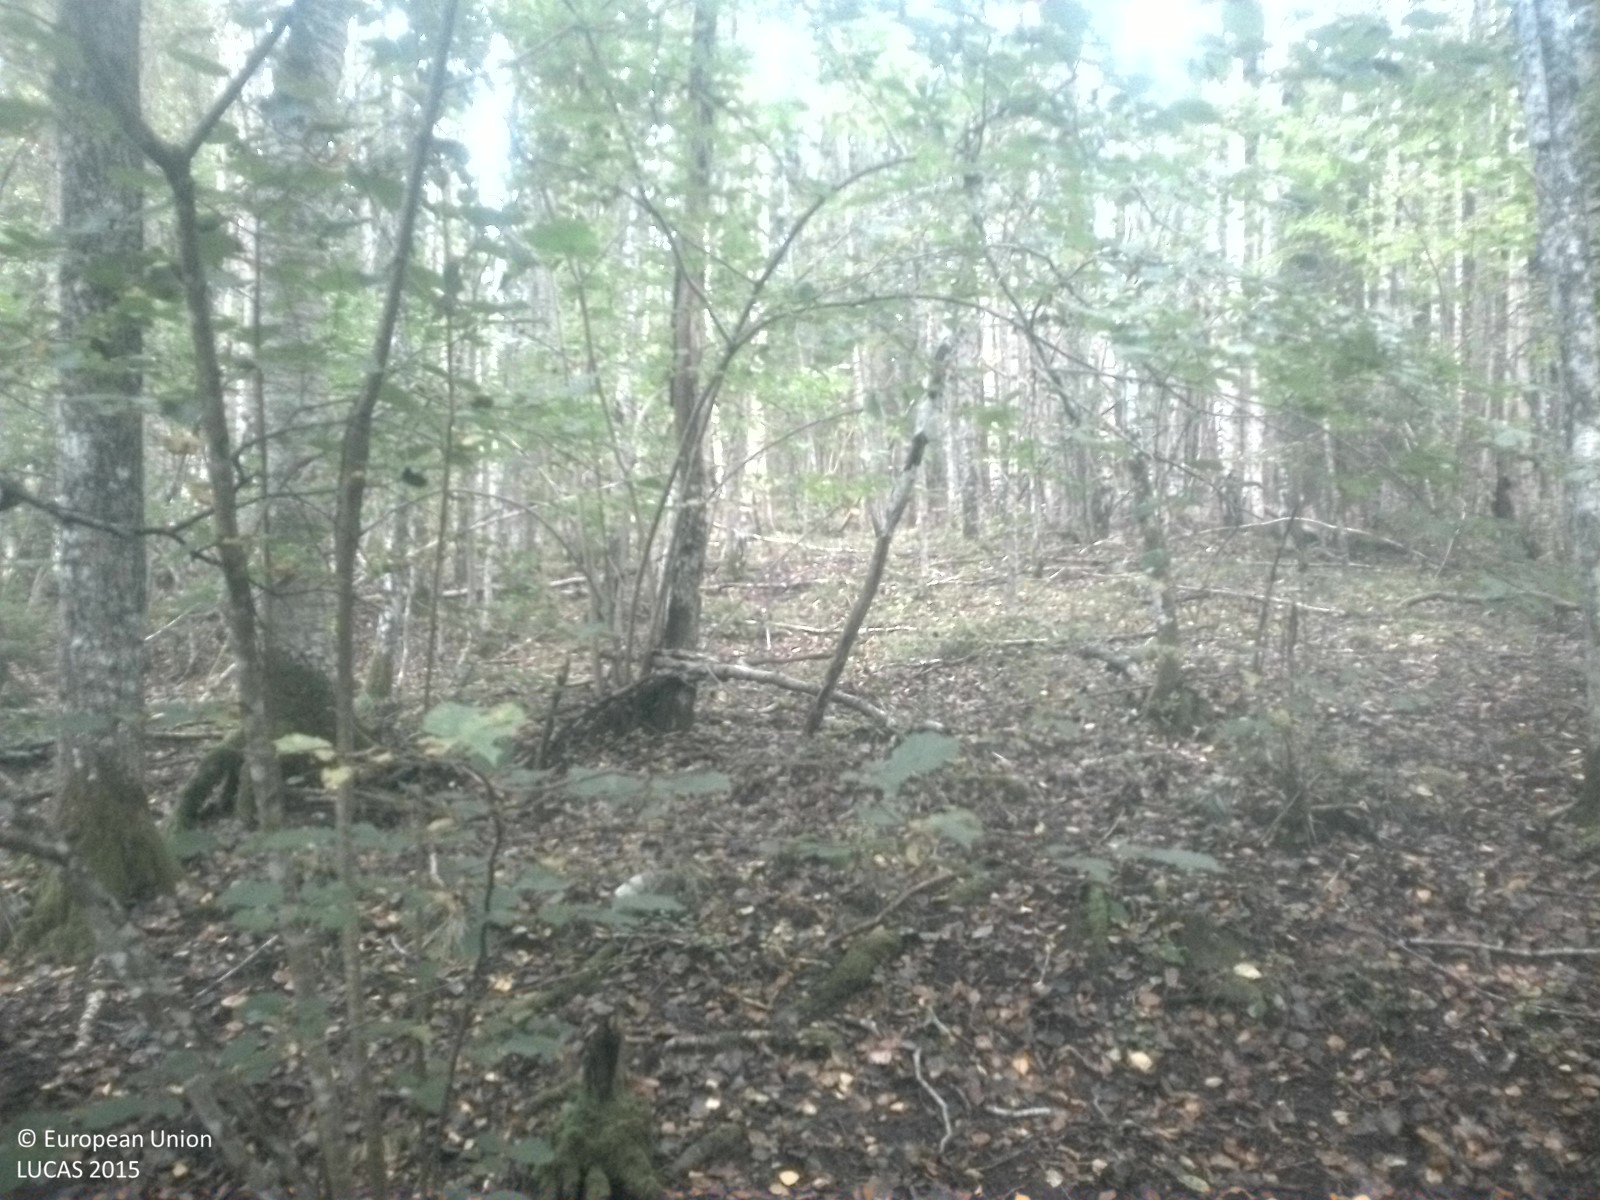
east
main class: Woodland
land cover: Broadleaved woodland
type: hemiboreal forest and nemoral coniferous forest and mixed broadleaved-coniferous forest
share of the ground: 50 - 75 %
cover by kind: broadleaved forest trees 55 %, unconsolidated bare surface 20 %, herbaceous plants 10 %, lichens and mosses 10 %, coniferous forest trees 5 %
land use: Forestry
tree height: > 5 m
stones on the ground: < 10 %
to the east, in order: Broadleaved woodland; Spruce dominated mixed woodland; Grassland with sparse tree/shrub cover; Electric lines; Grassland with sparse tree/shrub cover; Spruce dominated coniferous woodland; Spruce dominated mixed woodland; Broadleaved woodland
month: September
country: SE
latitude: 58.8923
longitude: 15.7025
